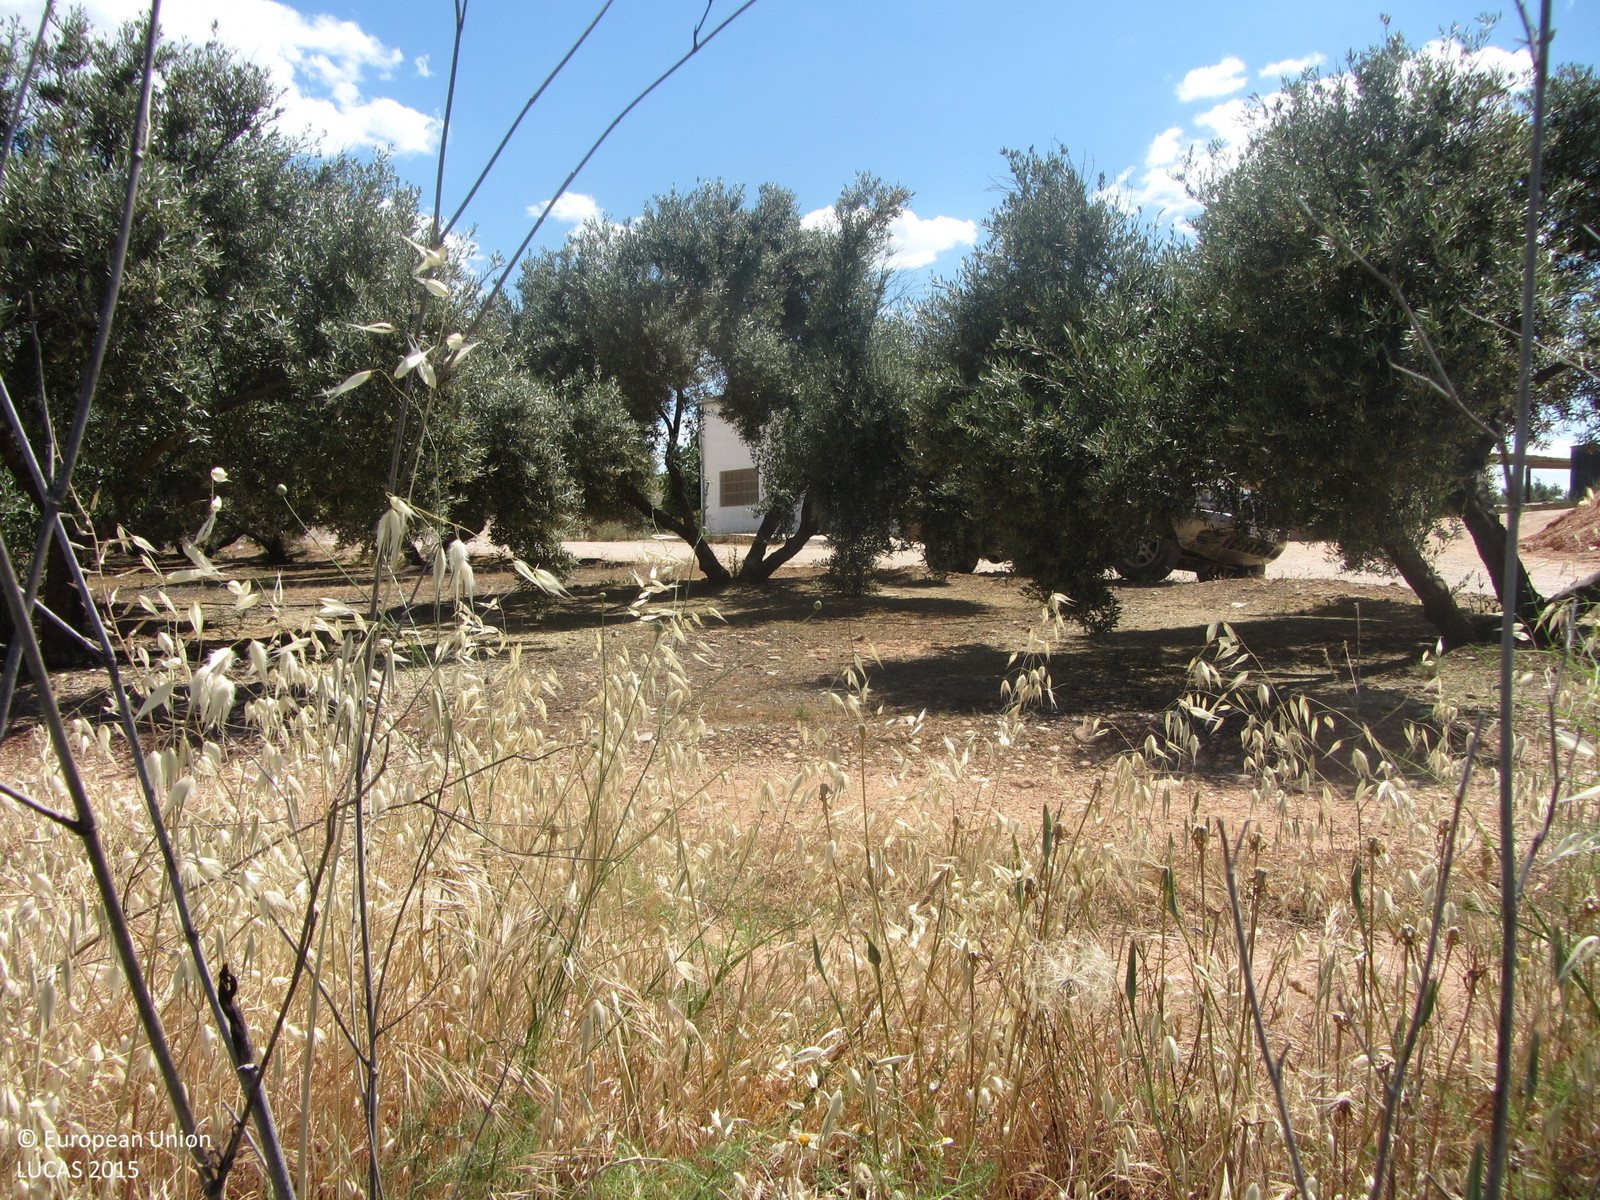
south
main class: Grassland
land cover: Grassland without tree/shrub cover
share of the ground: 50 - 75 %
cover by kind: herbaceous plants 65 %, consolidated bare surface 20 %, shrubs 5 %
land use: Mining and quarrying
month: May
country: ES
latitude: 38.3325
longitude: -2.8929
